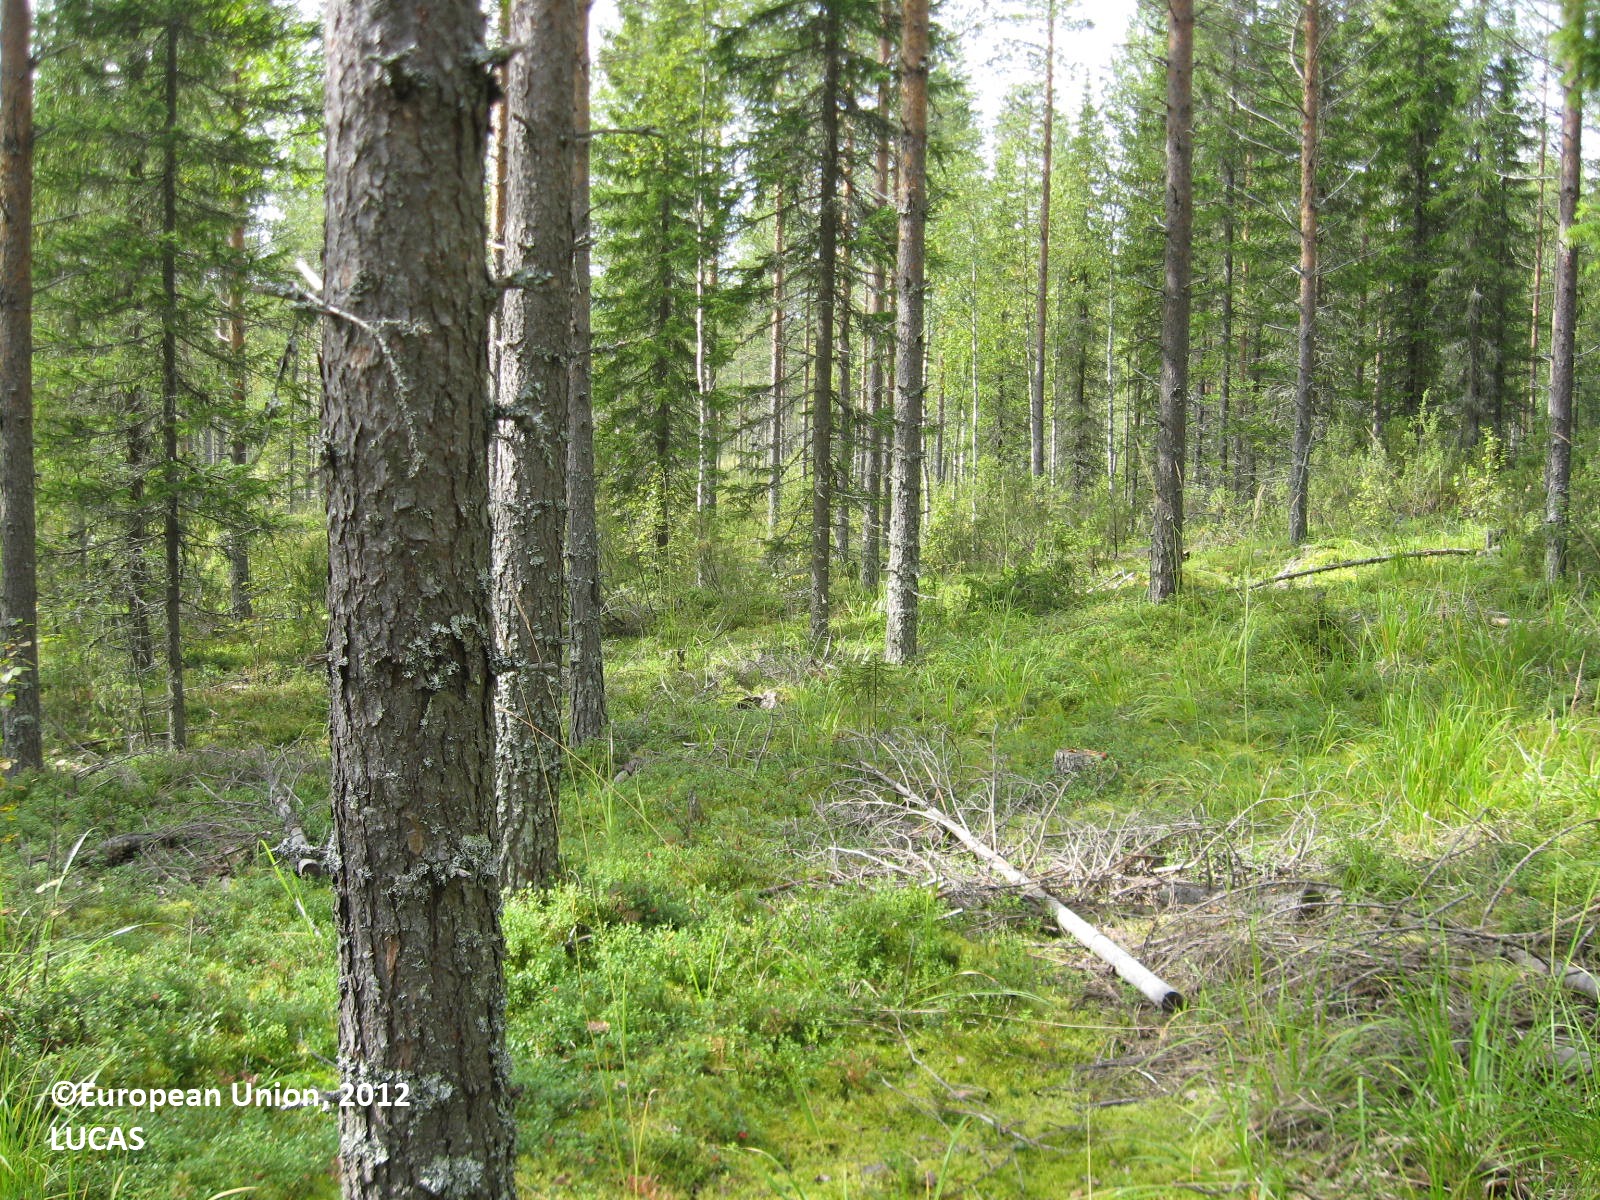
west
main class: Woodland
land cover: Pine dominated coniferous woodland
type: boreal forest
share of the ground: 50 - 75 %
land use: Forestry
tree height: > 5 m
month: August
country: FI
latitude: 63.7762
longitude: 29.1339
